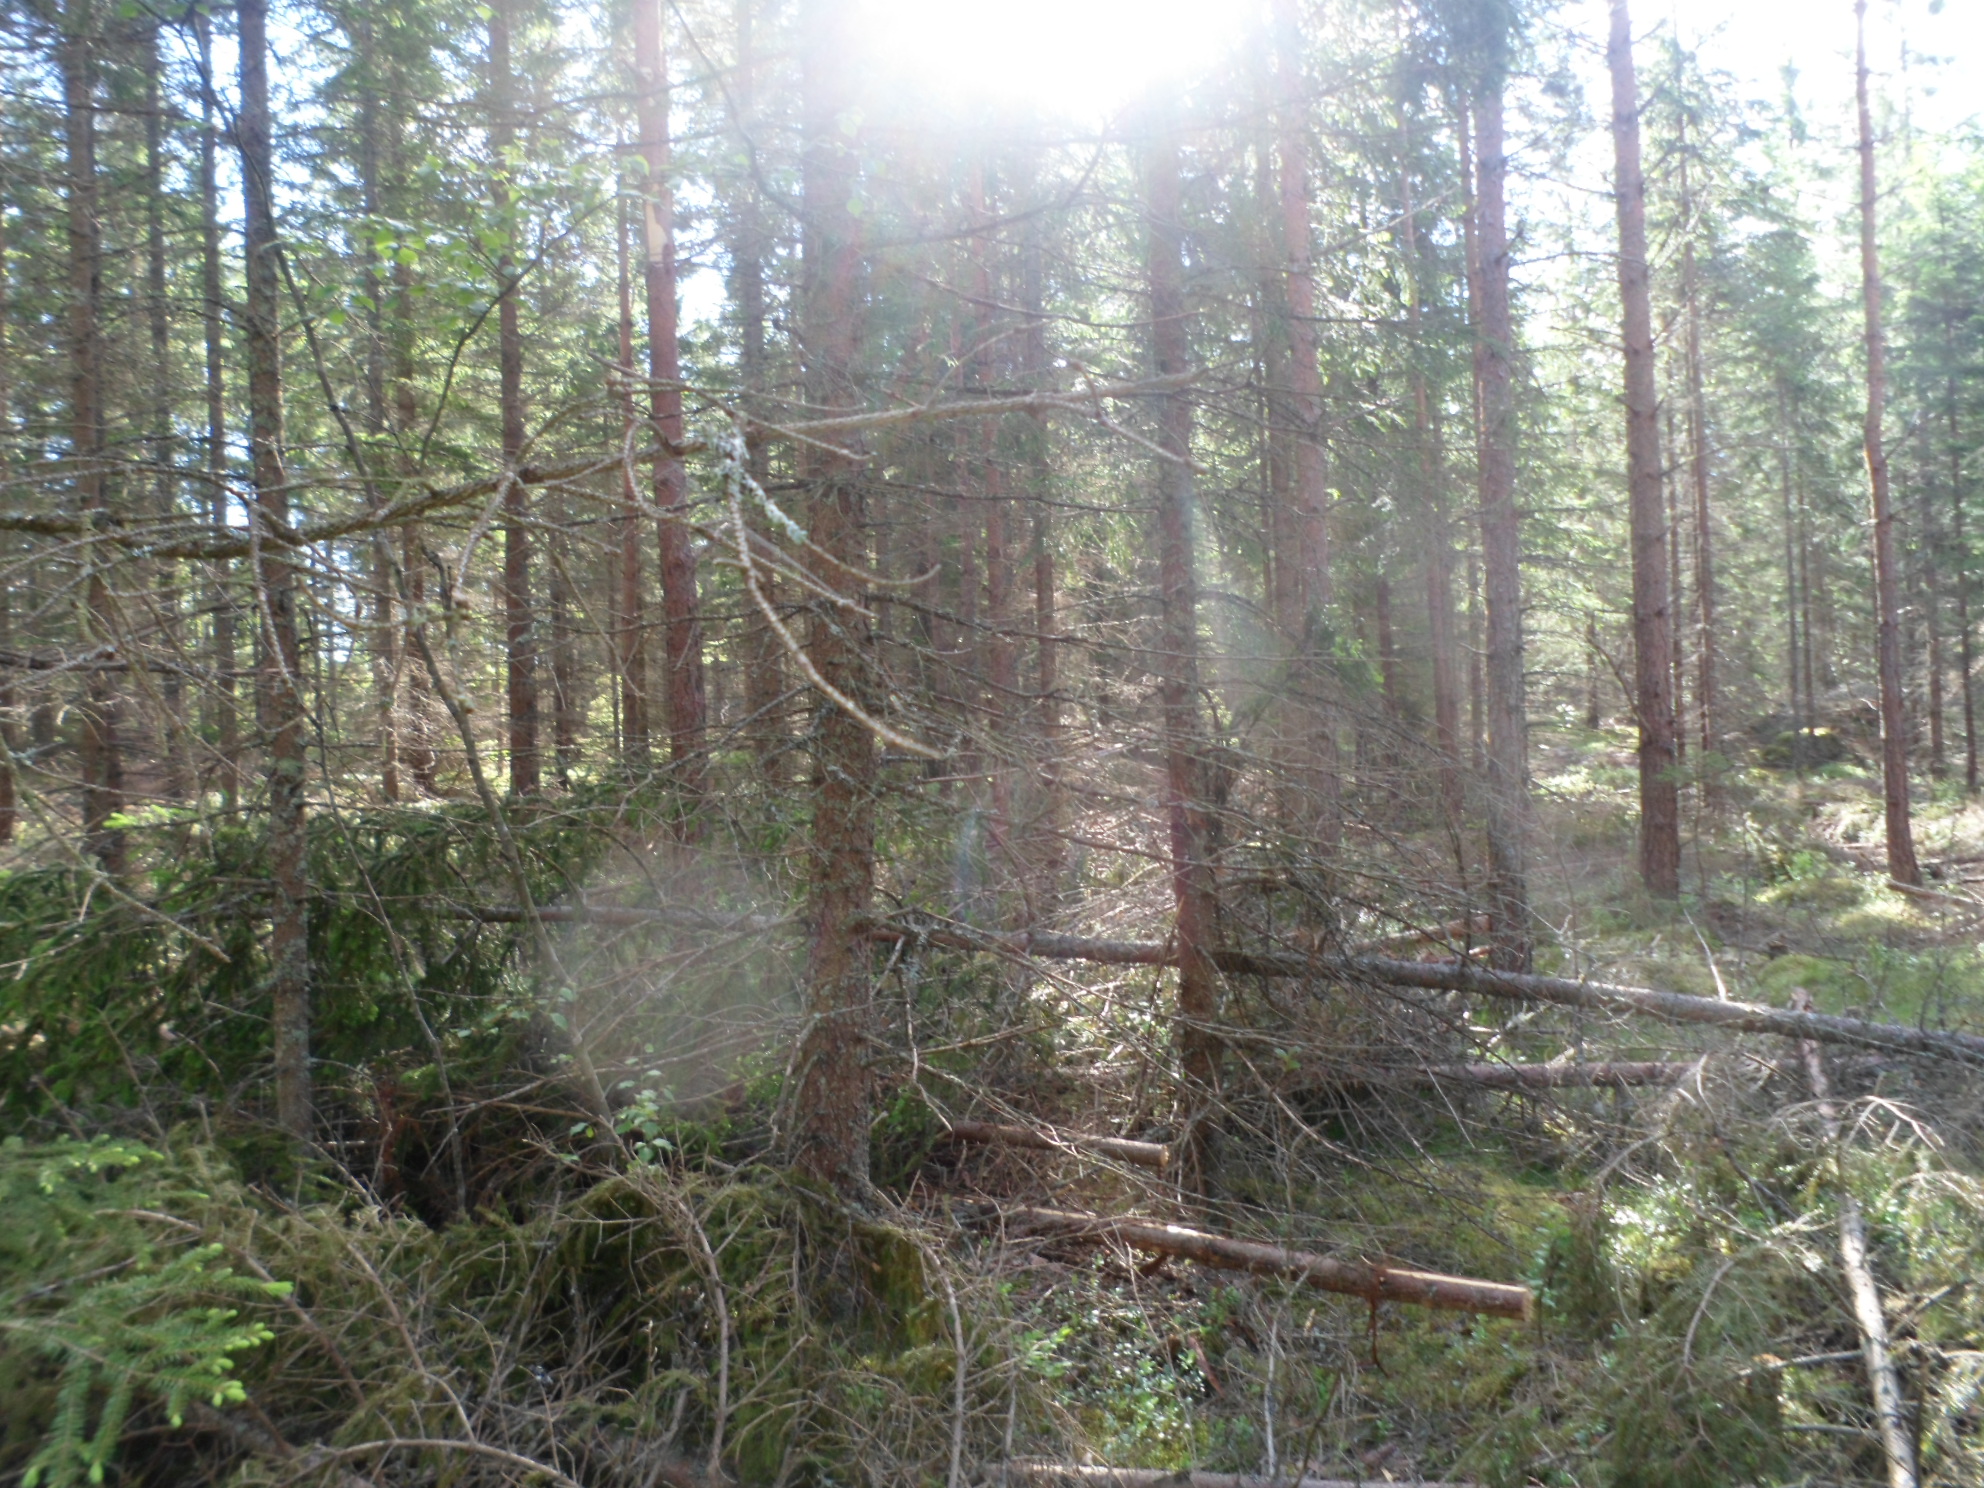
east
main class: Woodland
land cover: Spruce dominated coniferous woodland
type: boreal forest
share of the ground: 50 - 75 %
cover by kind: coniferous forest trees 55 %, lichens and mosses 25 %, shrubs 10 %, unconsolidated bare surface 10 %
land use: Forestry
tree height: > 5 m
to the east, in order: Spruce dominated coniferous woodland; Tracks; Spruce dominated coniferous woodland; Paved roads, cycling and walking lanes; Spruce dominated mixed woodland; Ditches and canals; Spruce dominated mixed woodland
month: June
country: SE
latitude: 57.0259
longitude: 15.4838
